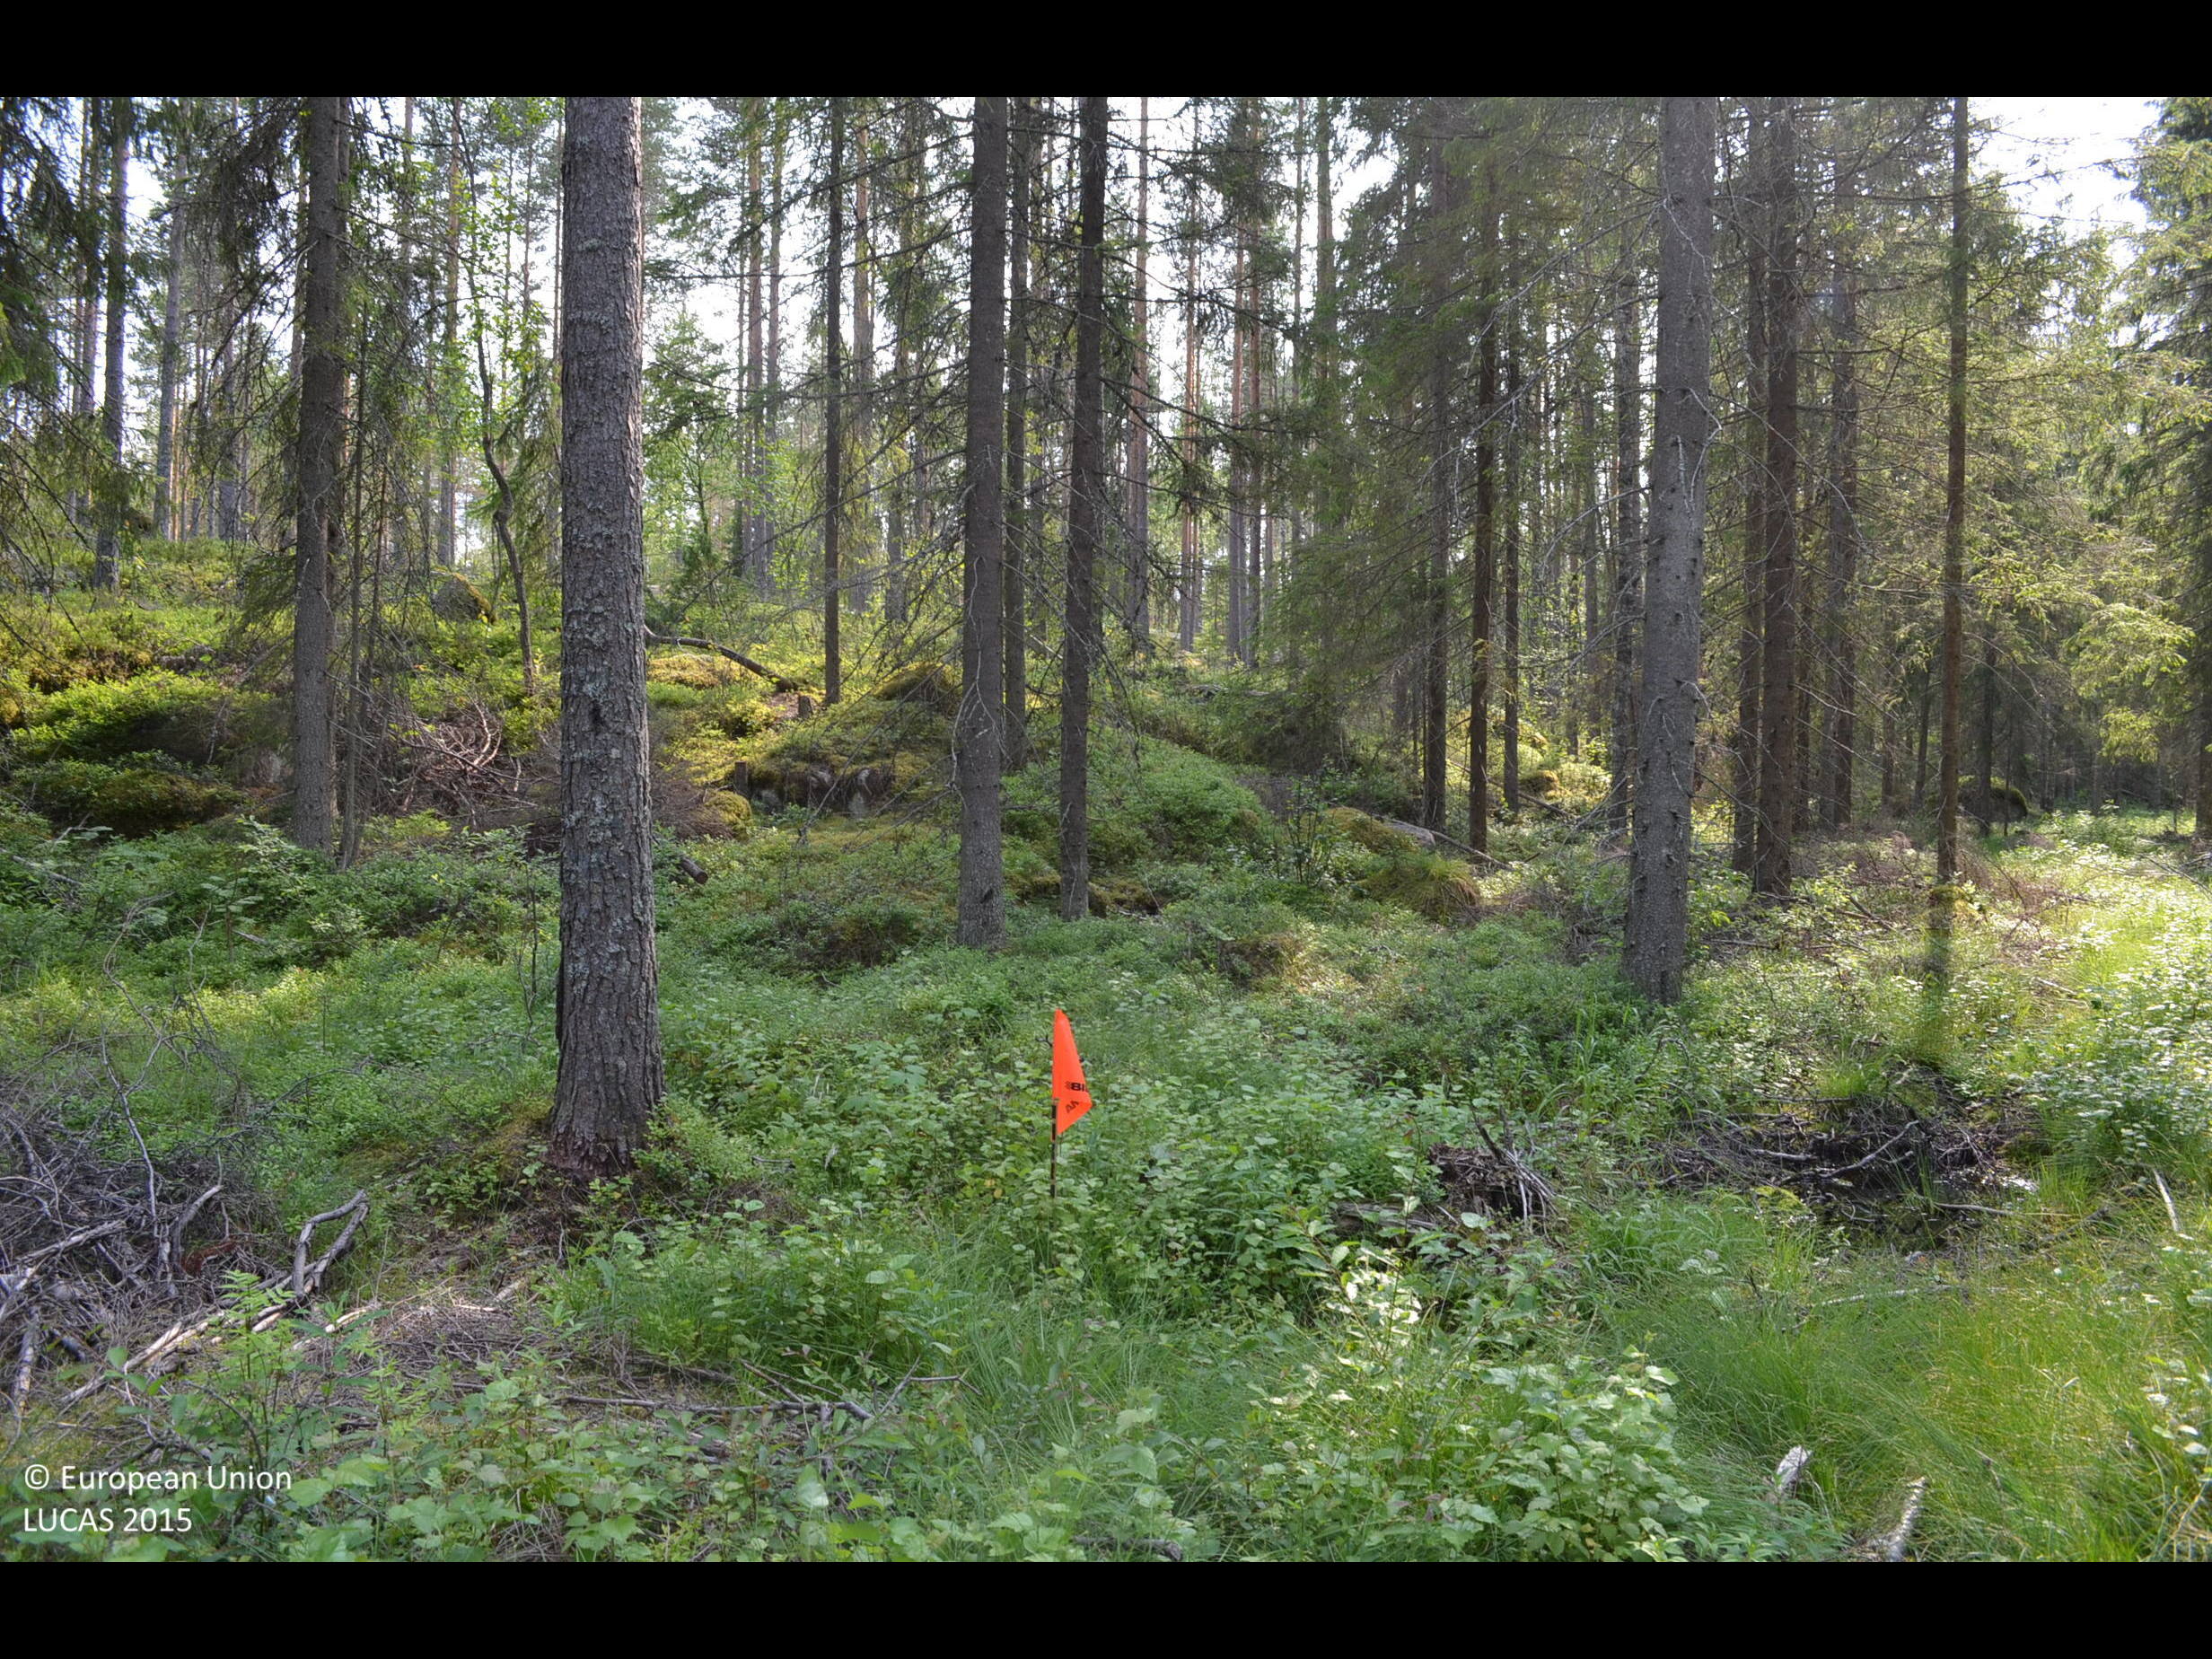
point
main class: Woodland
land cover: Other coniferous woodland
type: boreal forest
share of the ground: 50 - 75 %
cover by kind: coniferous forest trees 60 %, shrubs 30 %, broadleaved forest trees 5 %, herbaceous plants 5 %
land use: Forestry
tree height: > 5 m
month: July
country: FI
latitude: 62.2193
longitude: 23.5170
